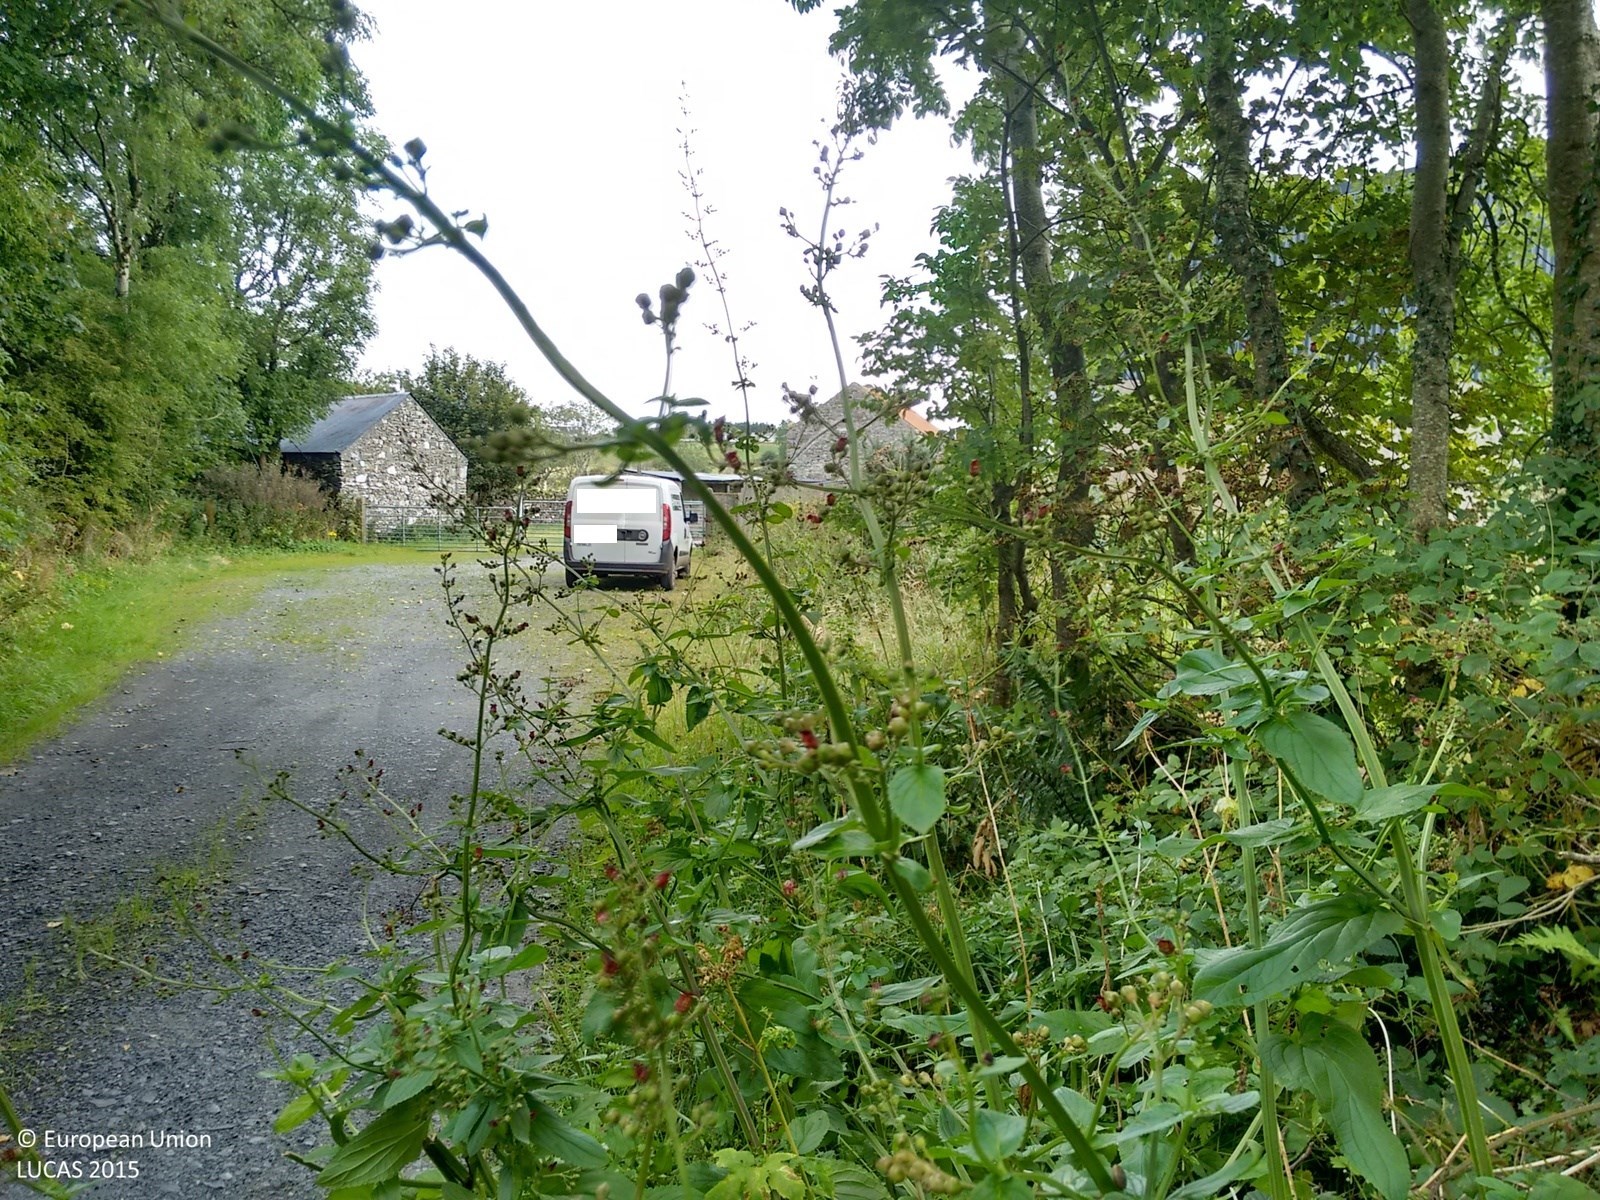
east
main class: Grassland
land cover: Grassland without tree/shrub cover
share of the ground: > 75 %
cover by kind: herbaceous plants 100 %
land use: Agriculture (excluding fallow land and kitchen gardens)
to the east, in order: Grassland without tree/shrub cover; Artificial constructions in urban areas; Grassland without tree/shrub cover; Broadleaved woodland; Grassland without tree/shrub cover; Broadleaved woodland; Grassland without tree/shrub cover
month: September
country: IE
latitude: 55.2247
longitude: -7.2657
